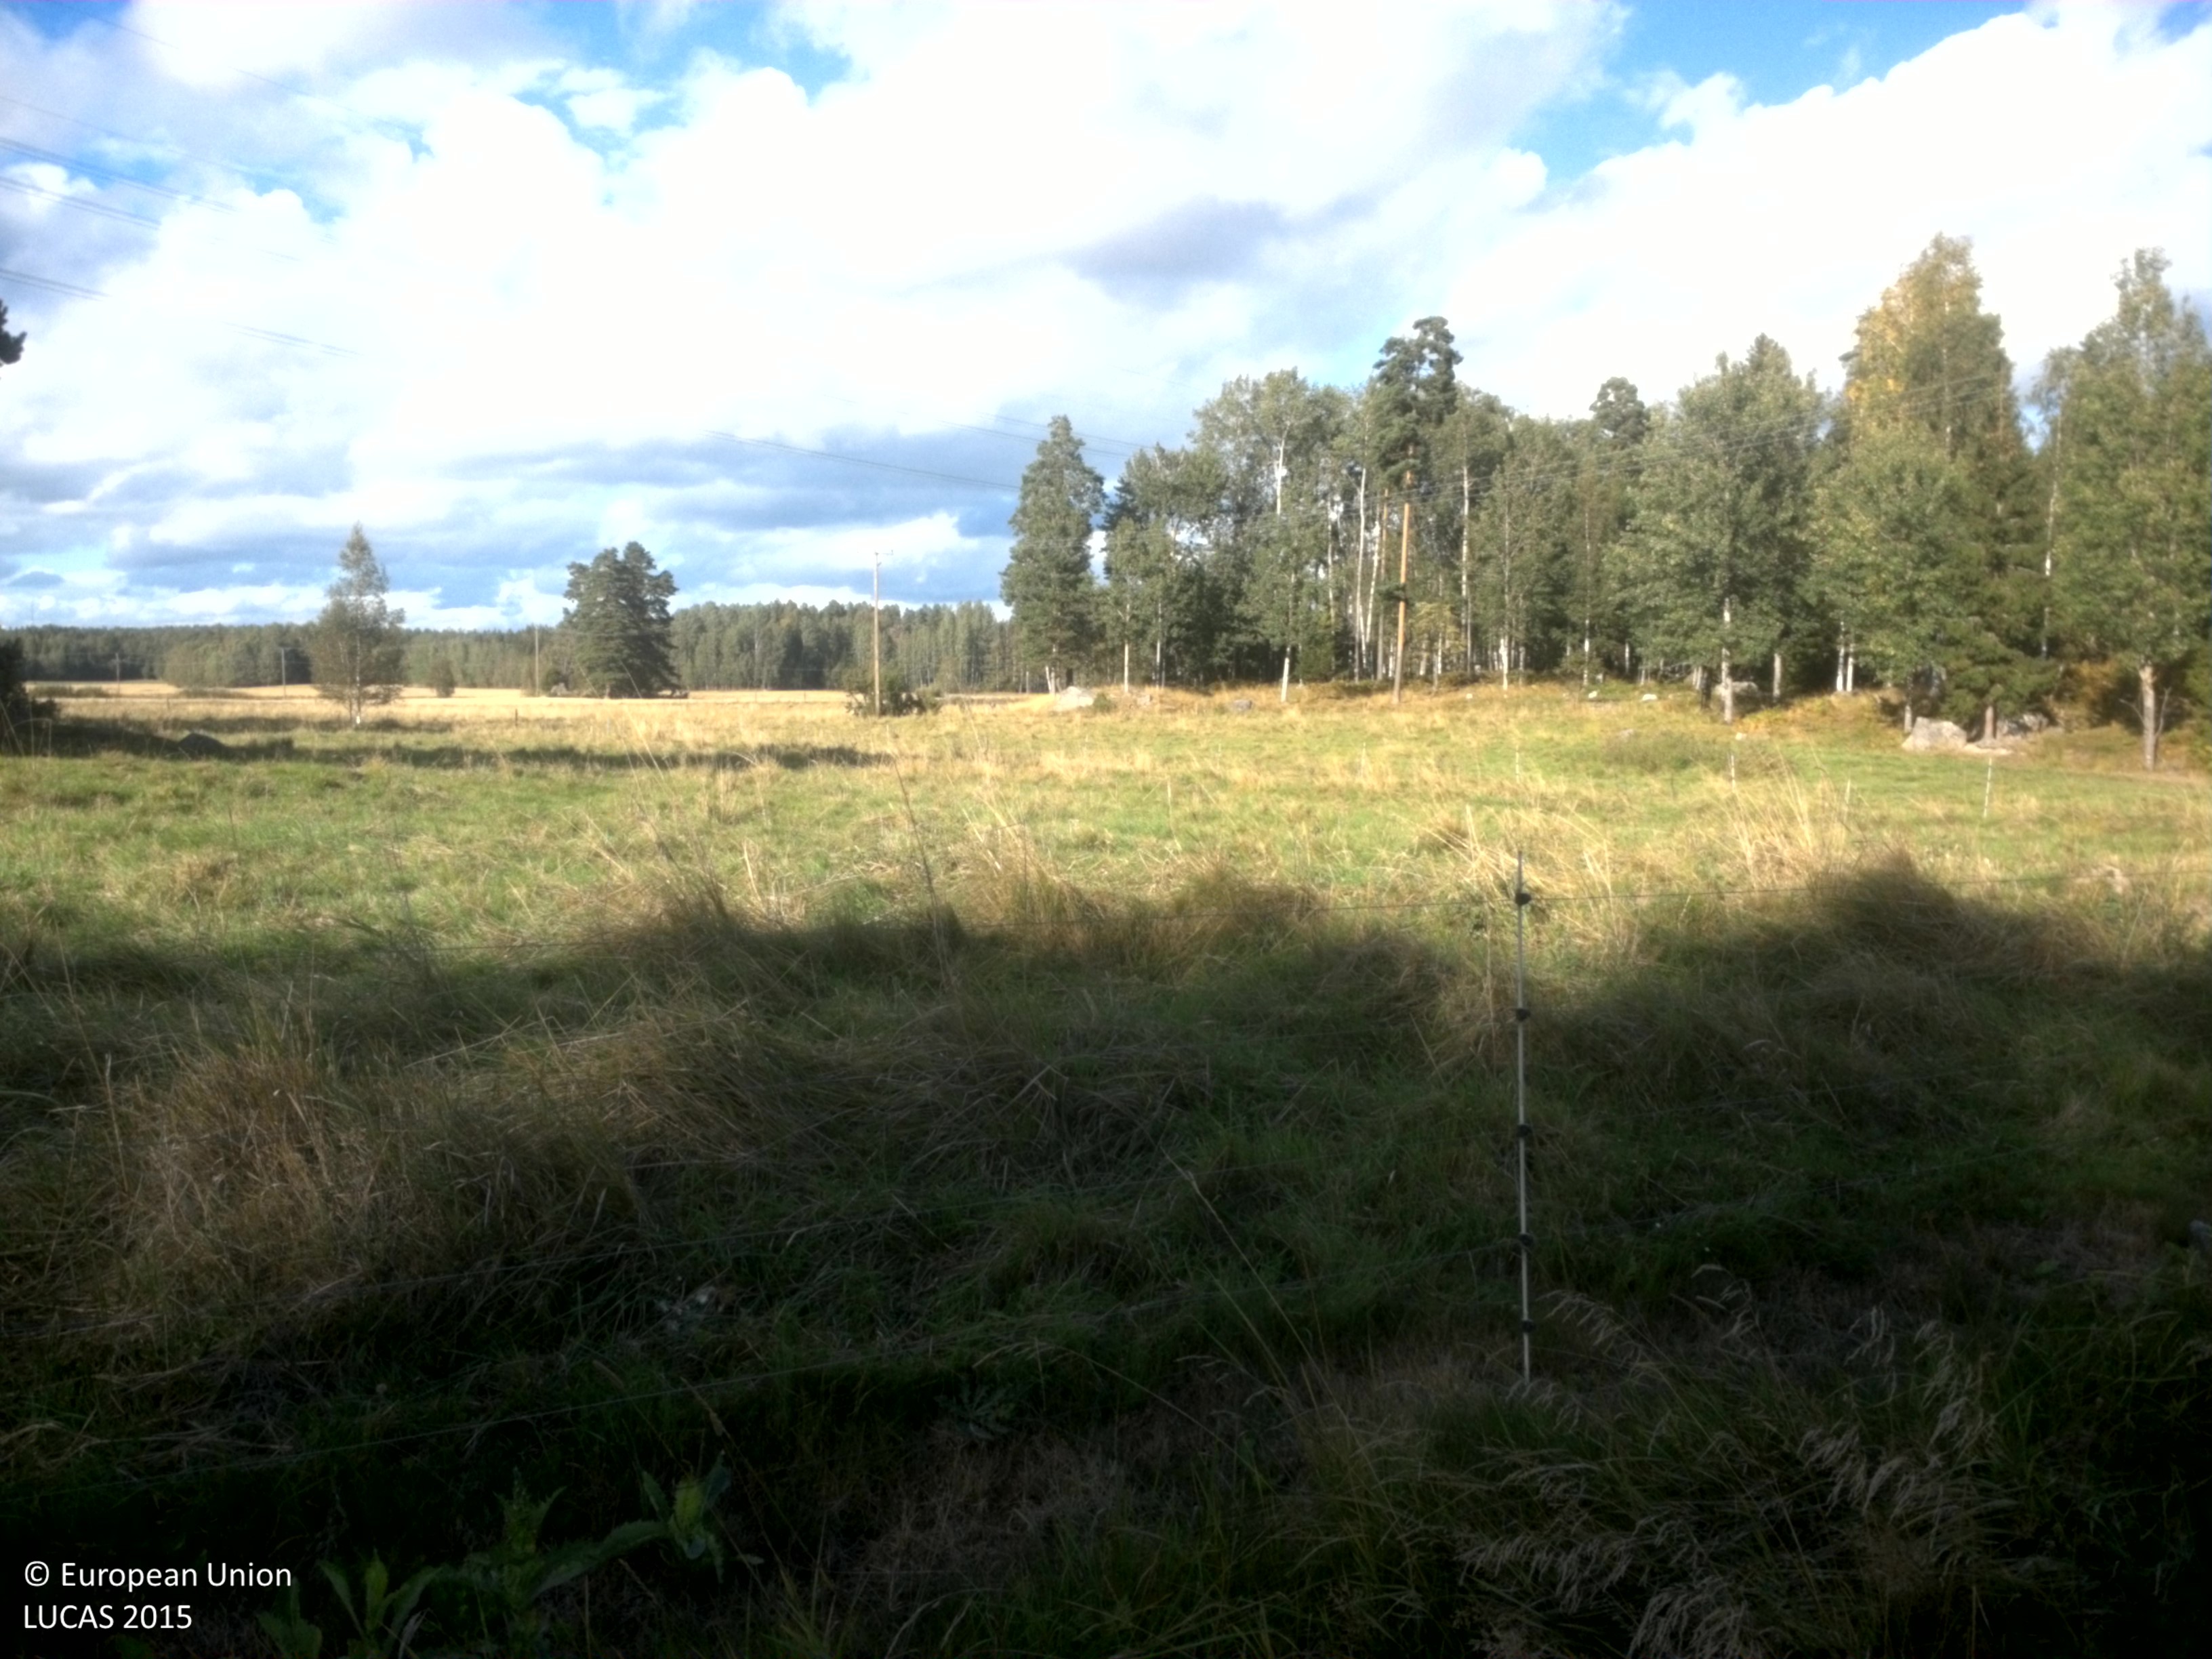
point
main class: Grassland
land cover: Grassland without tree/shrub cover
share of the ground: > 75 %
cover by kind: herbaceous plants 100 %
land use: Agriculture (excluding fallow land and kitchen gardens)
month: August
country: SE
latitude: 59.4358
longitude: 15.6509
